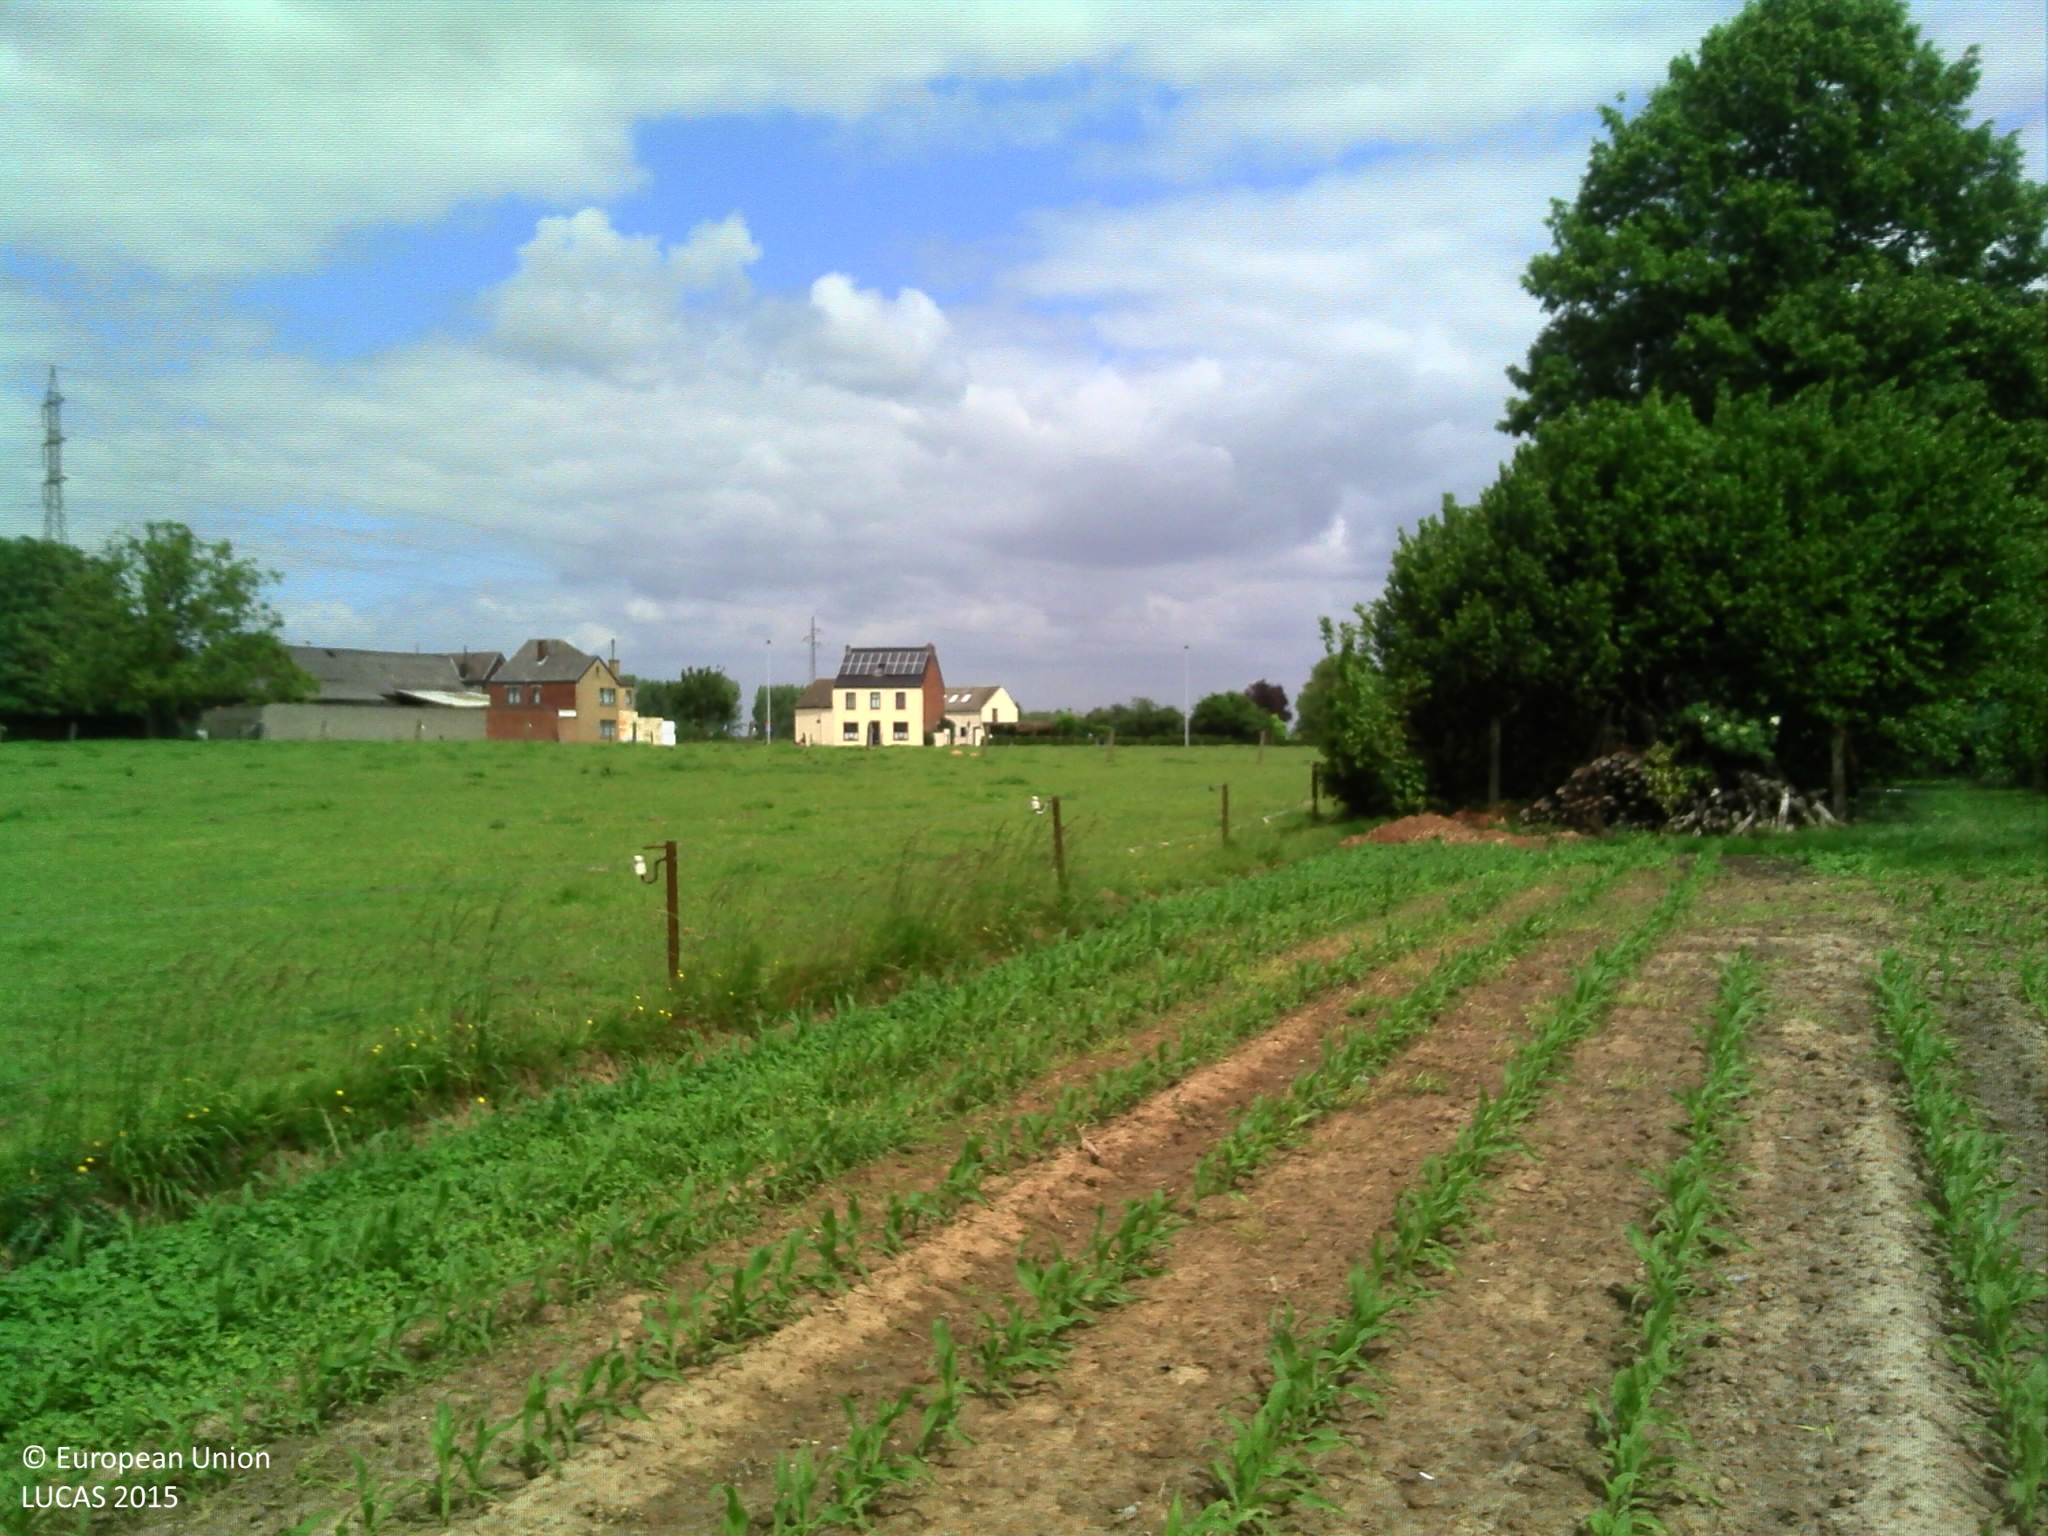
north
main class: Cropland
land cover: Maize
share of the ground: 25 - 50 %
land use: Agriculture (excluding fallow land and kitchen gardens)
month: June
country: BE
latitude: 50.8757
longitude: 4.0396
